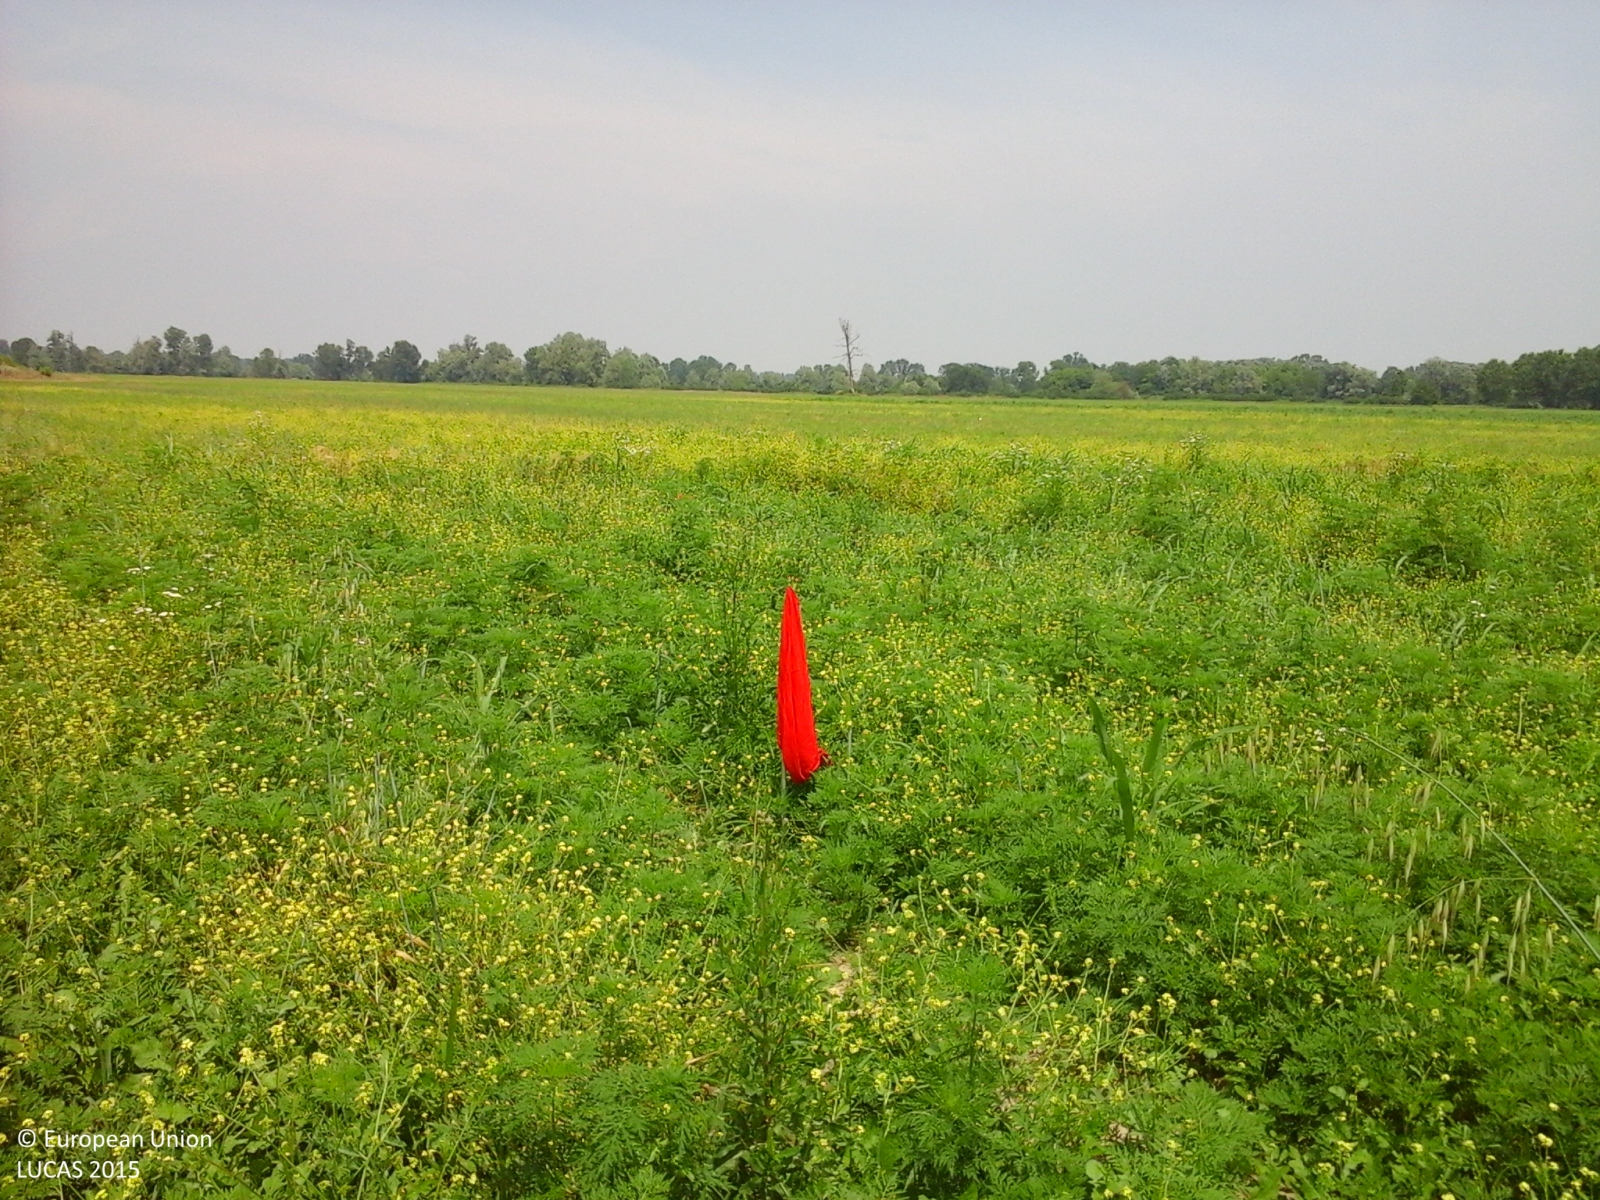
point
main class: Grassland
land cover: Spontaneously vegetated surfaces
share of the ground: > 75 %
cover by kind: herbaceous plants 100 %
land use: Agriculture (excluding fallow land and kitchen gardens)
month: June
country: IT
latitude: 45.2695
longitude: 9.6565
